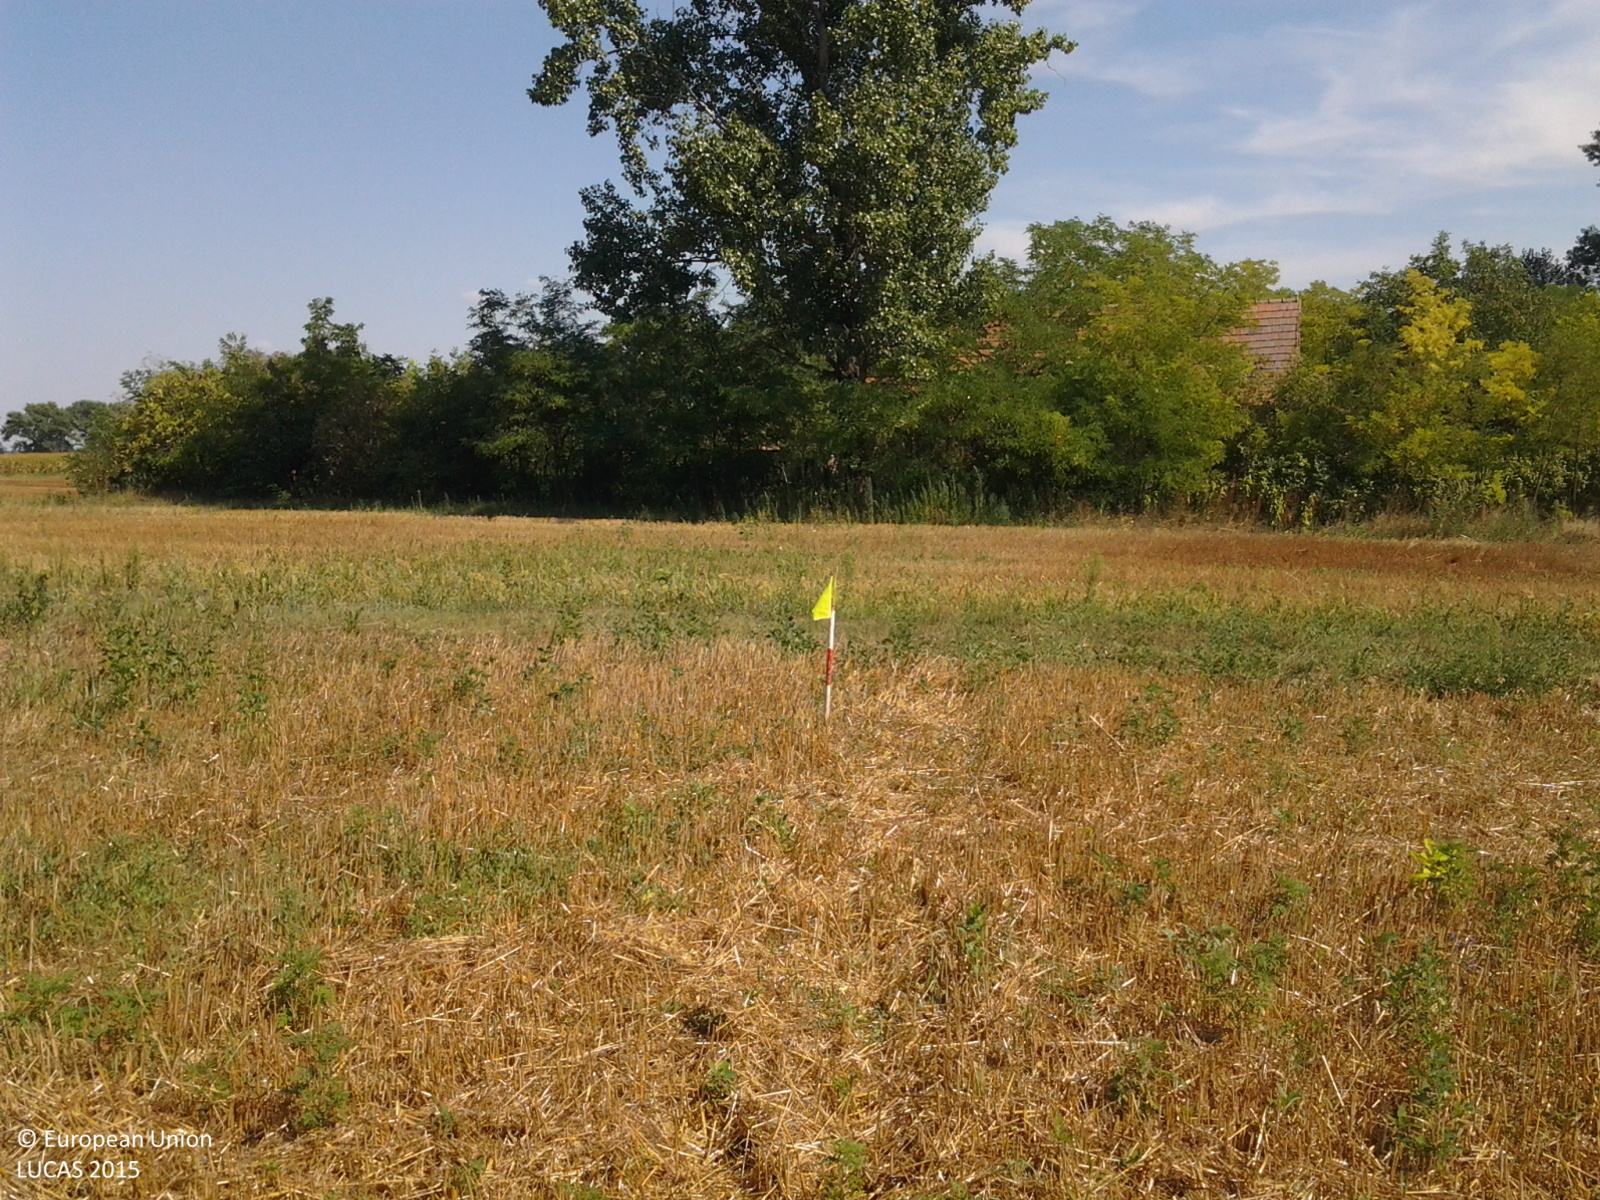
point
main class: Cropland
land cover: Triticale
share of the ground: > 75 %
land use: Agriculture (excluding fallow land and kitchen gardens)
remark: Harvested field
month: August
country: HU
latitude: 47.3681
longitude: 19.8096
